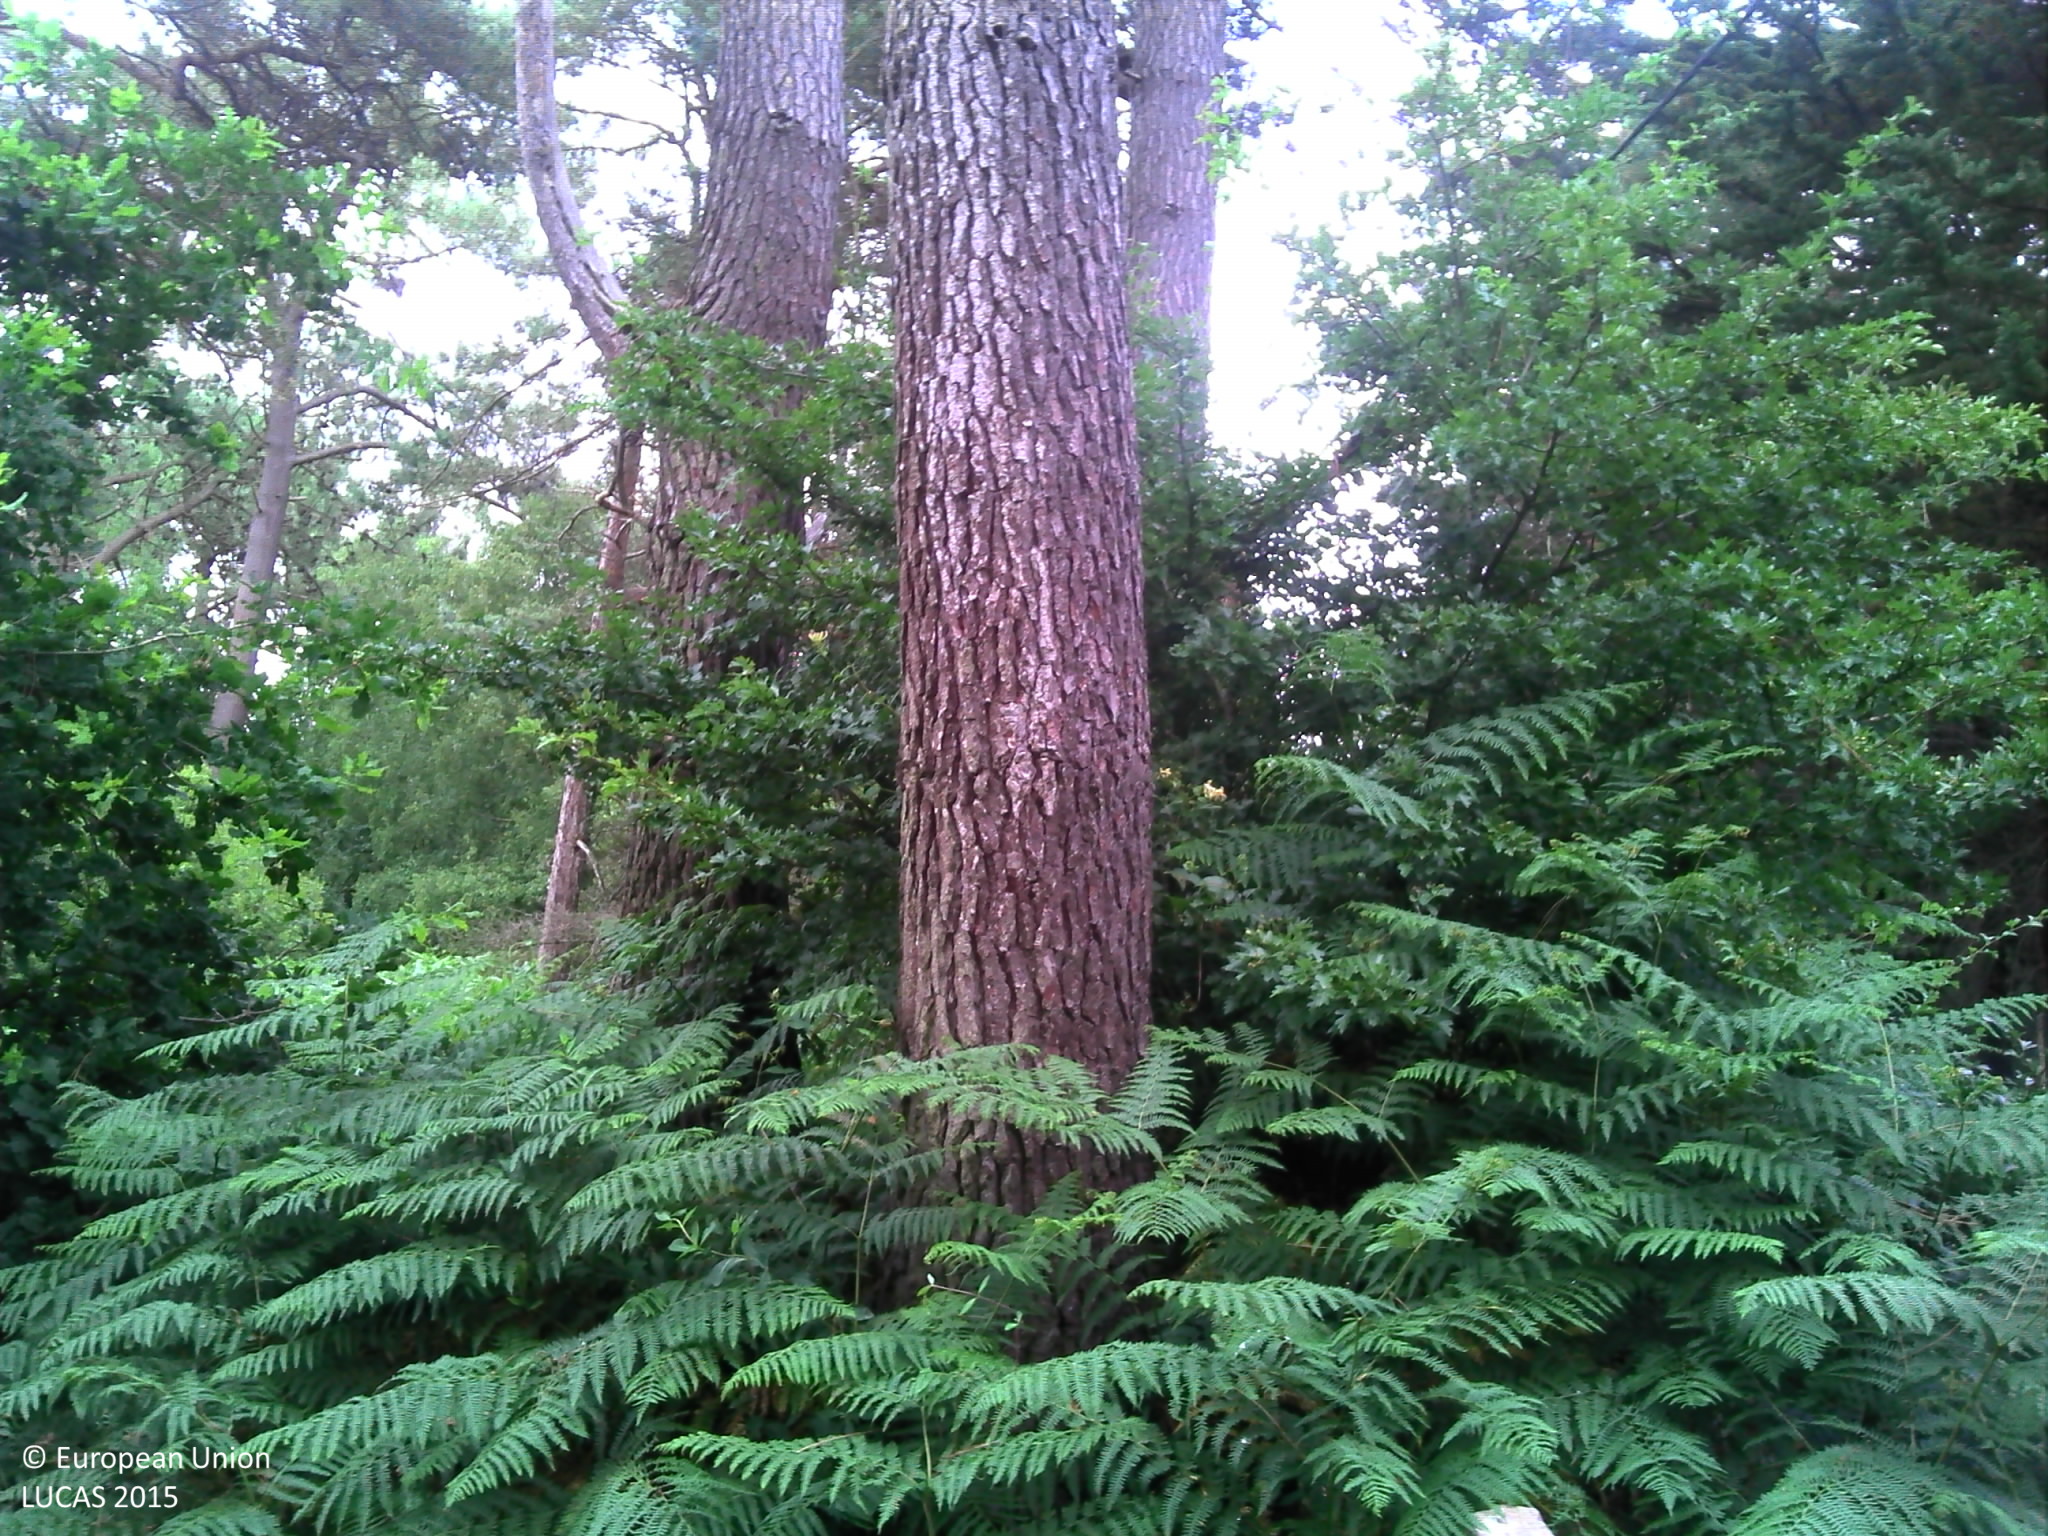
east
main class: Woodland
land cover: Pine dominated mixed woodland
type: exotic forest
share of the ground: > 75 %
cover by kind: herbaceous plants 40 %, unconsolidated bare surface 20 %, coniferous forest trees 15 %, broadleaved forest trees 15 %, lichens and mosses 10 %
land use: Forestry
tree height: > 5 m
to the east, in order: Pine dominated mixed woodland; Fences; Grassland without tree/shrub cover; Fences; Tracks; Spruce dominated mixed woodland; Grassland without tree/shrub cover
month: July
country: FR
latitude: 48.6429
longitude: -2.4526
